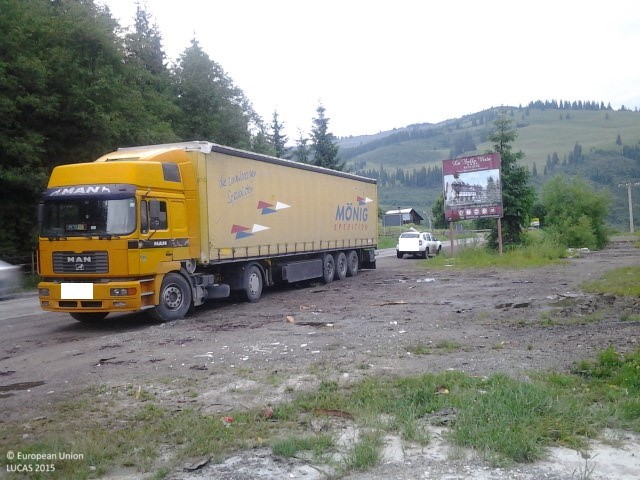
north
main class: Grassland
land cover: Spontaneously vegetated surfaces
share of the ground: > 75 %
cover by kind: herbaceous plants 100 %
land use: Abandoned areas
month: June
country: RO
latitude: 47.3348
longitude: 25.3976
